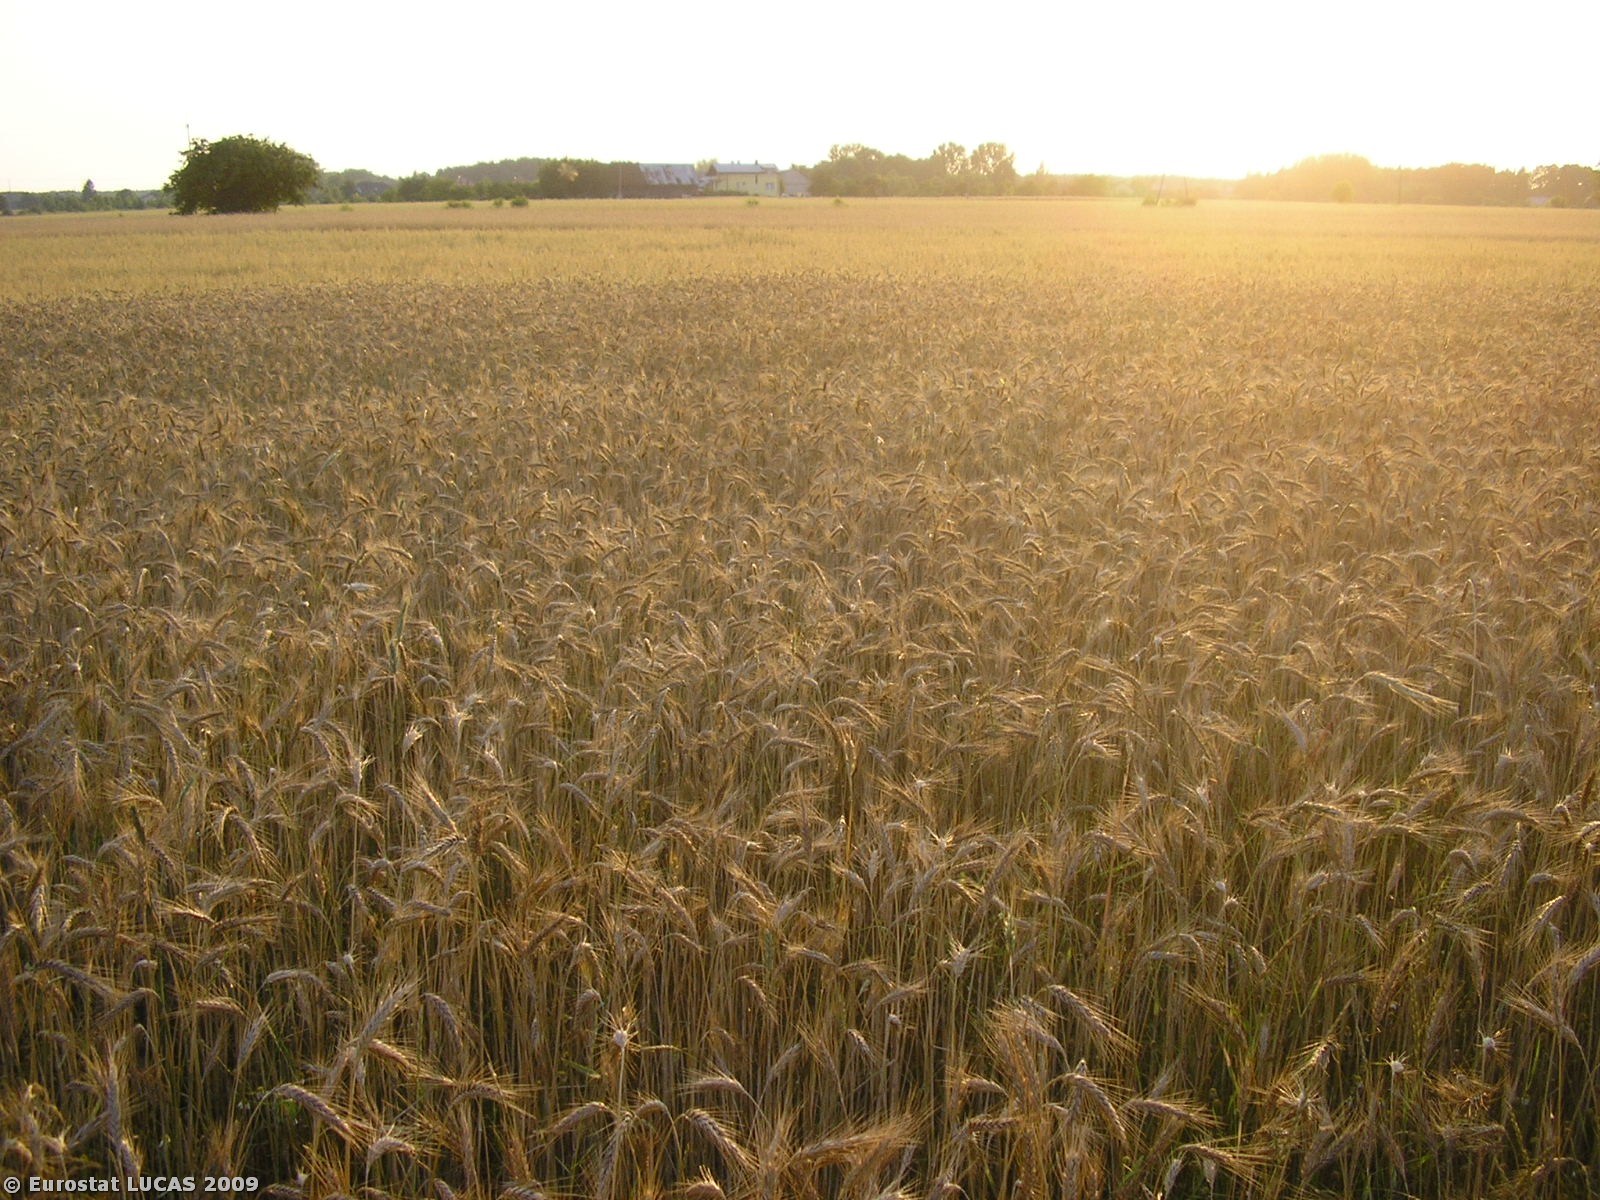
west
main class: Cropland
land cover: Triticale
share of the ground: > 75 %
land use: Agriculture (excluding fallow land and kitchen gardens)
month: July
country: PL
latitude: 52.4557
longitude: 20.8885
